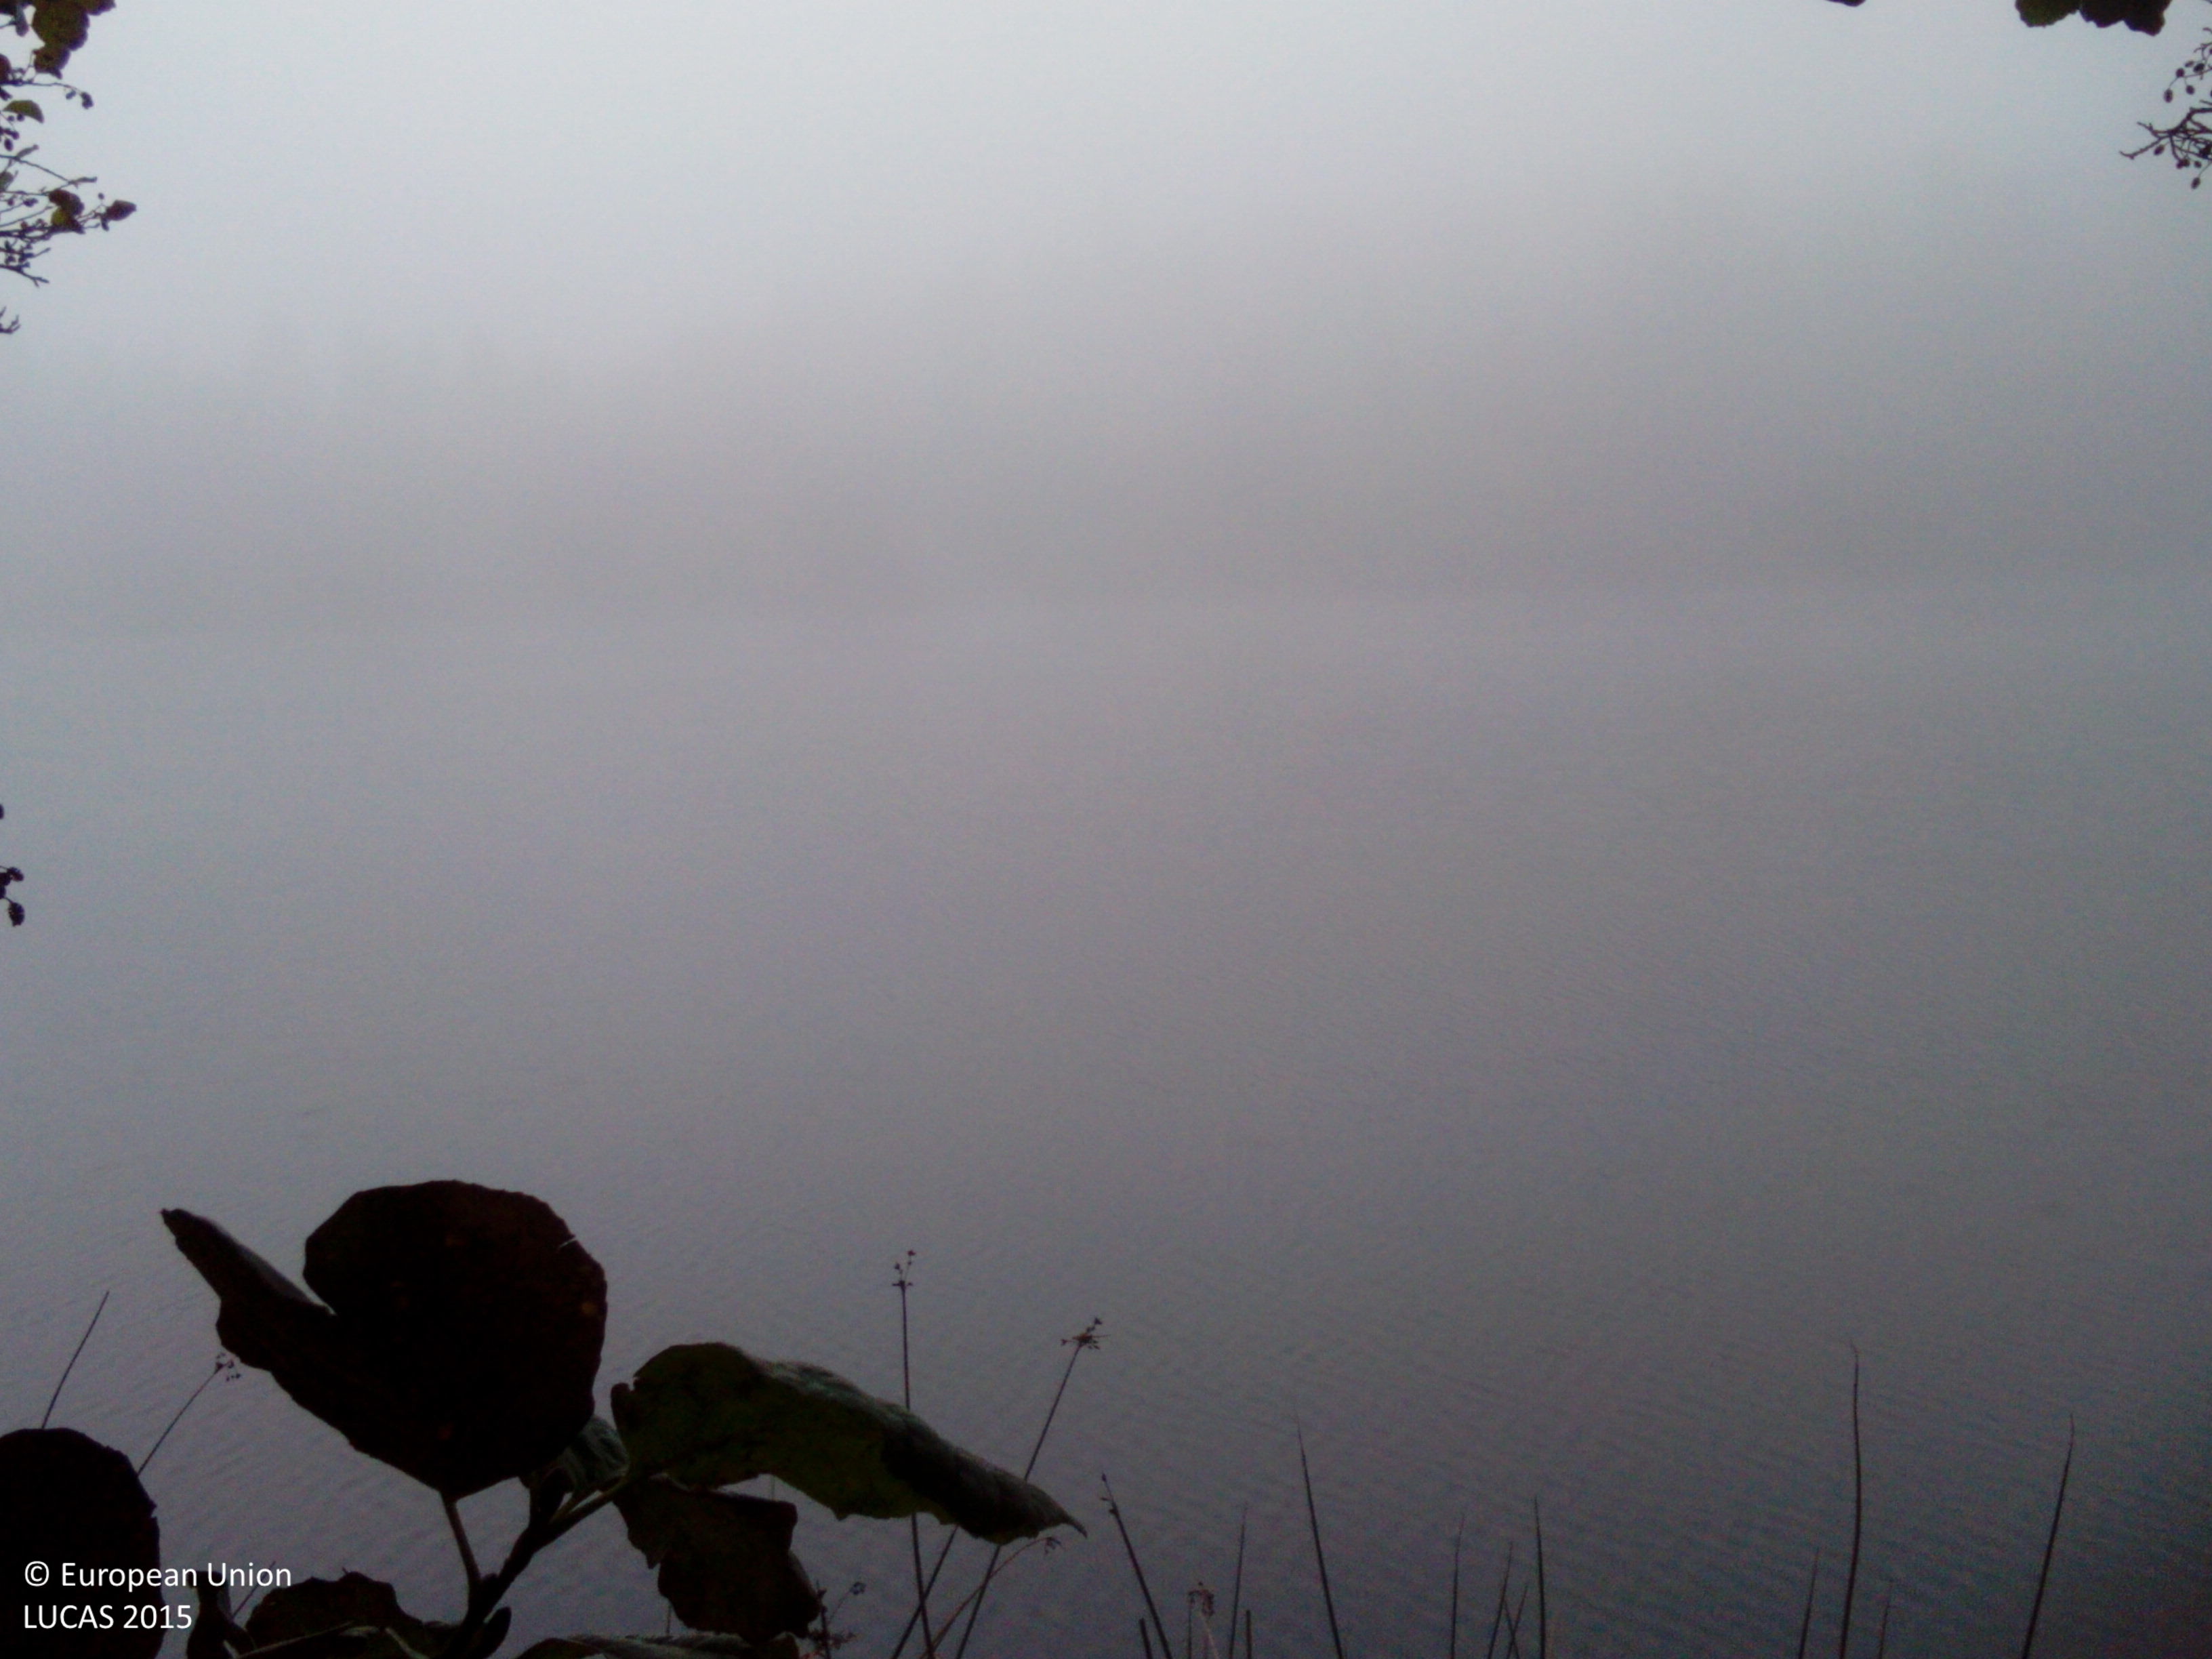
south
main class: Woodland
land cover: Pine dominated coniferous woodland
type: boreal forest
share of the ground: 25 - 50 %
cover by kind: coniferous forest trees 45 %
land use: Forestry
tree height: > 5 m
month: October
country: SE
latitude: 58.9448
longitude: 16.5468
